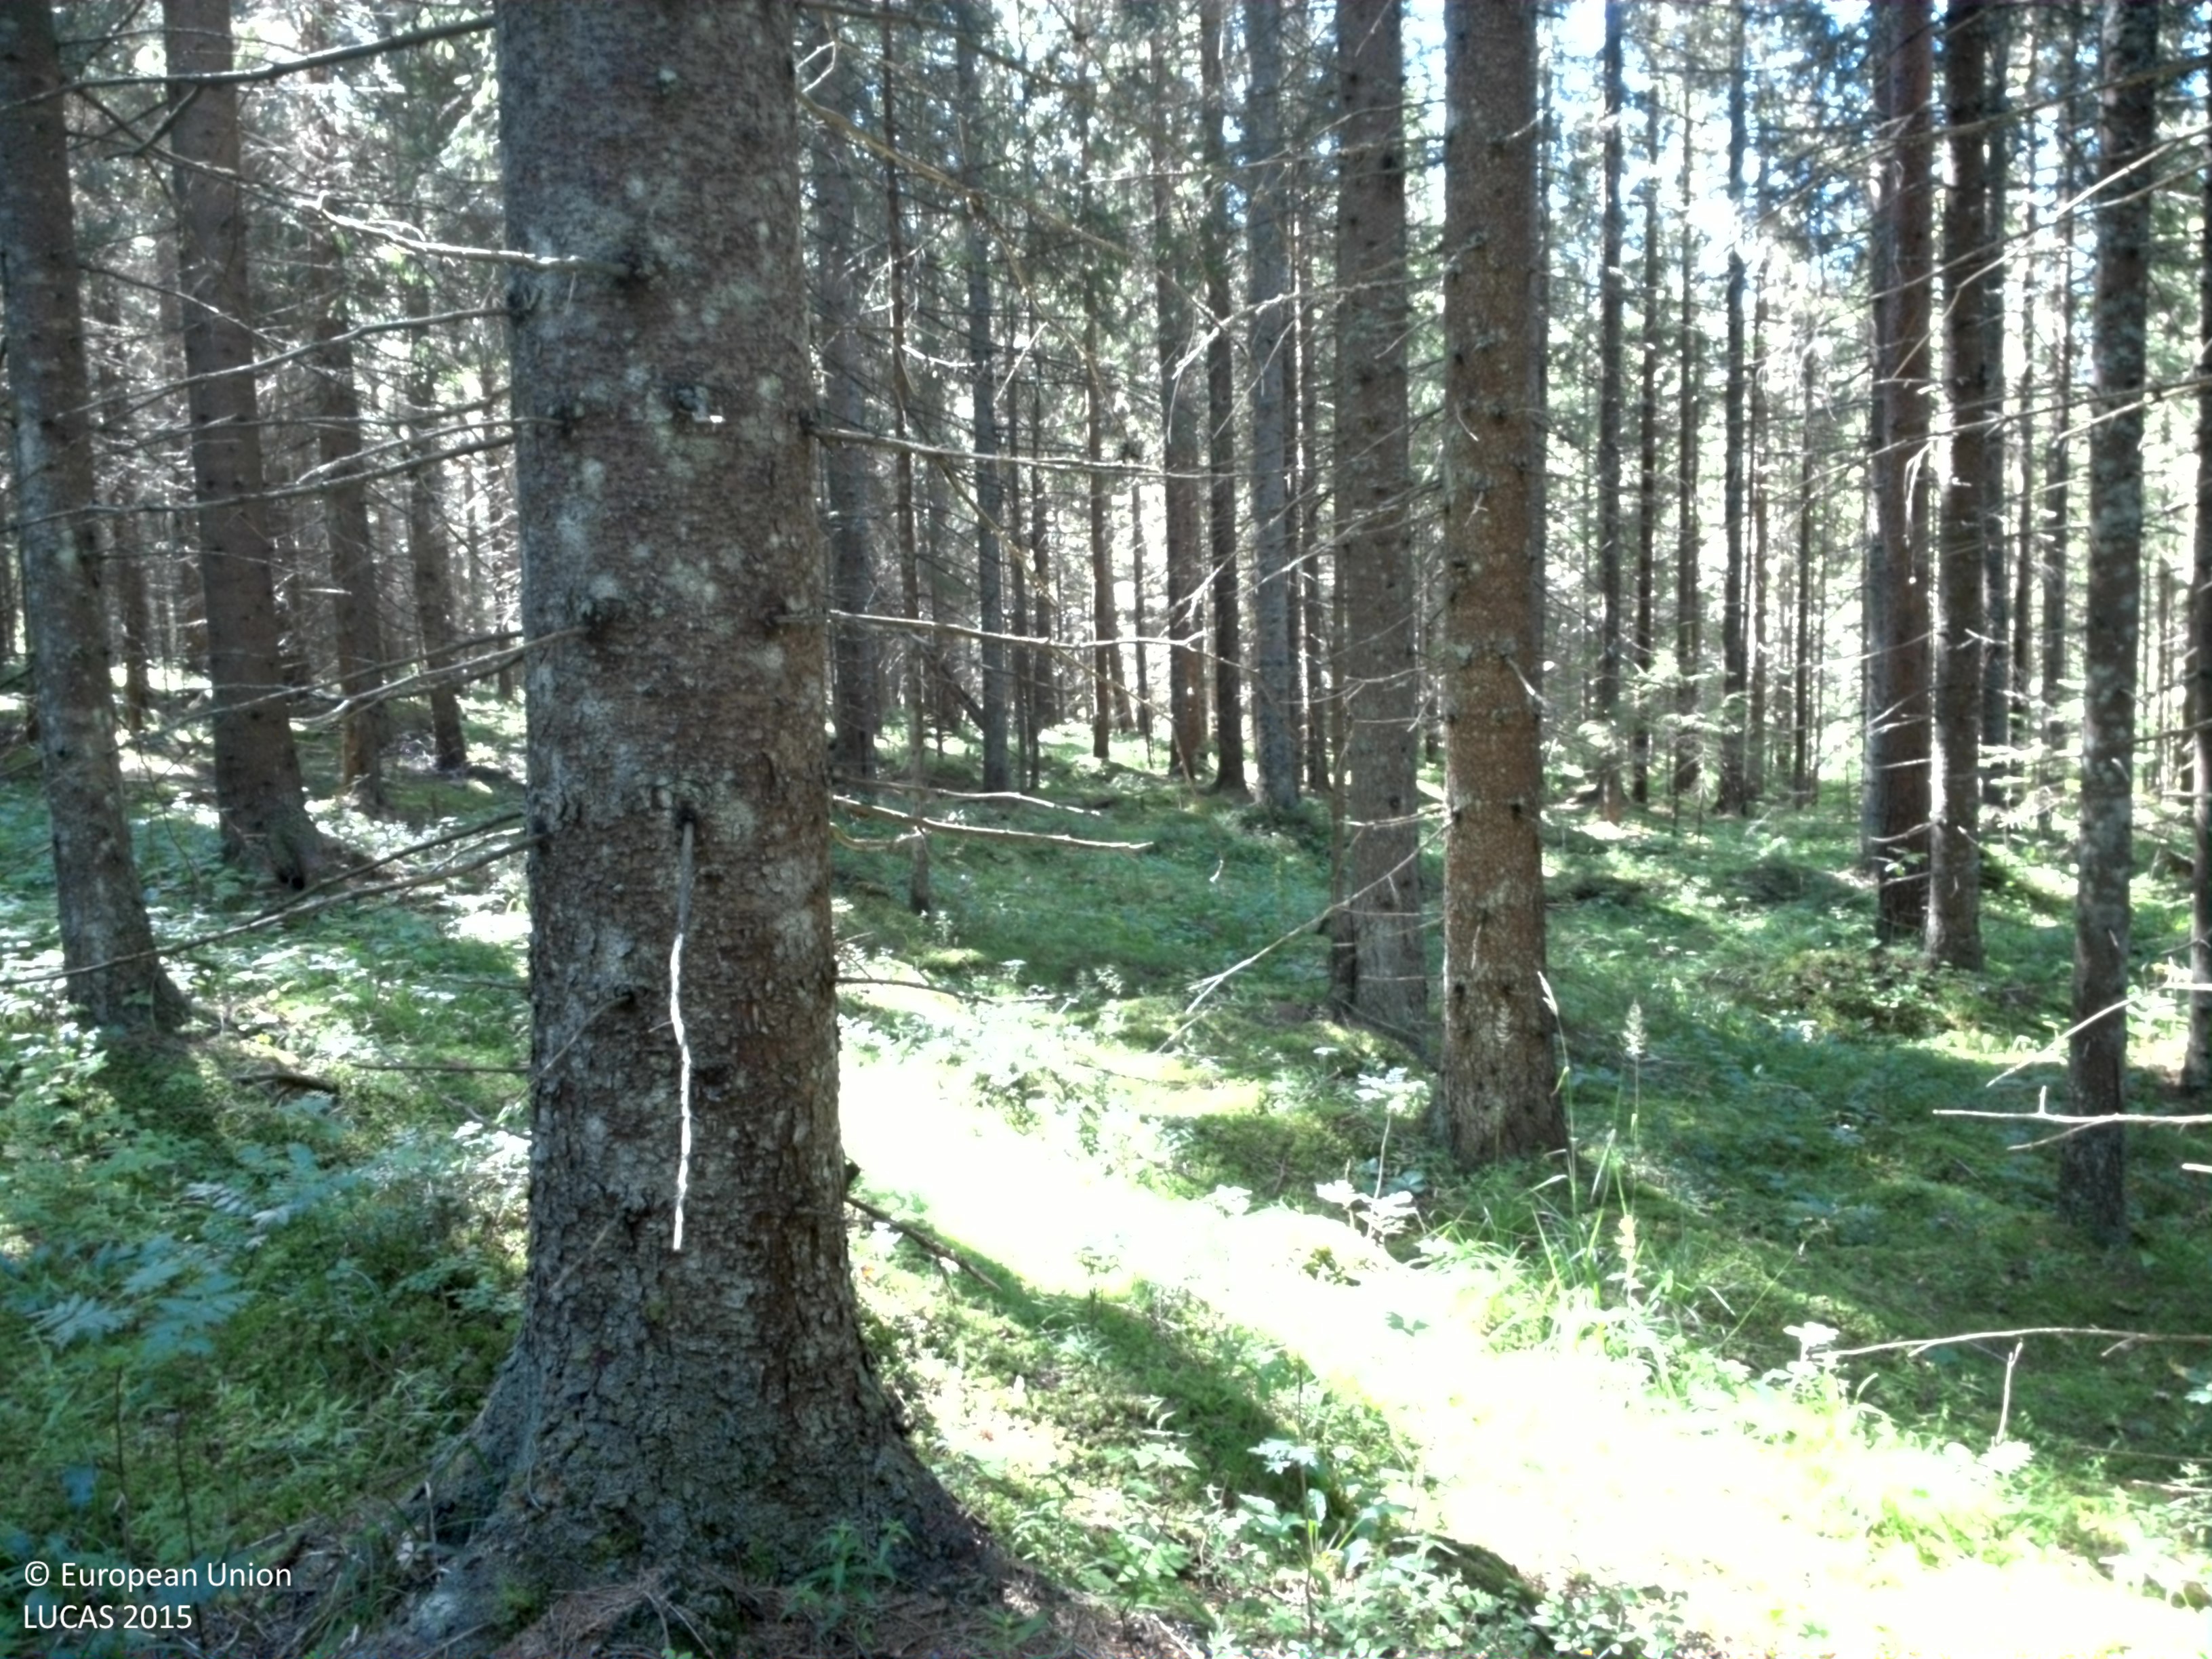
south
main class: Woodland
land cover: Spruce dominated coniferous woodland
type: boreal forest
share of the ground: > 75 %
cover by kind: coniferous forest trees 80 %, lichens and mosses 10 %, shrubs 5 %, herbaceous plants 5 %
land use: Forestry
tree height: > 5 m
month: August
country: SE
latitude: 59.9591
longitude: 14.0910
